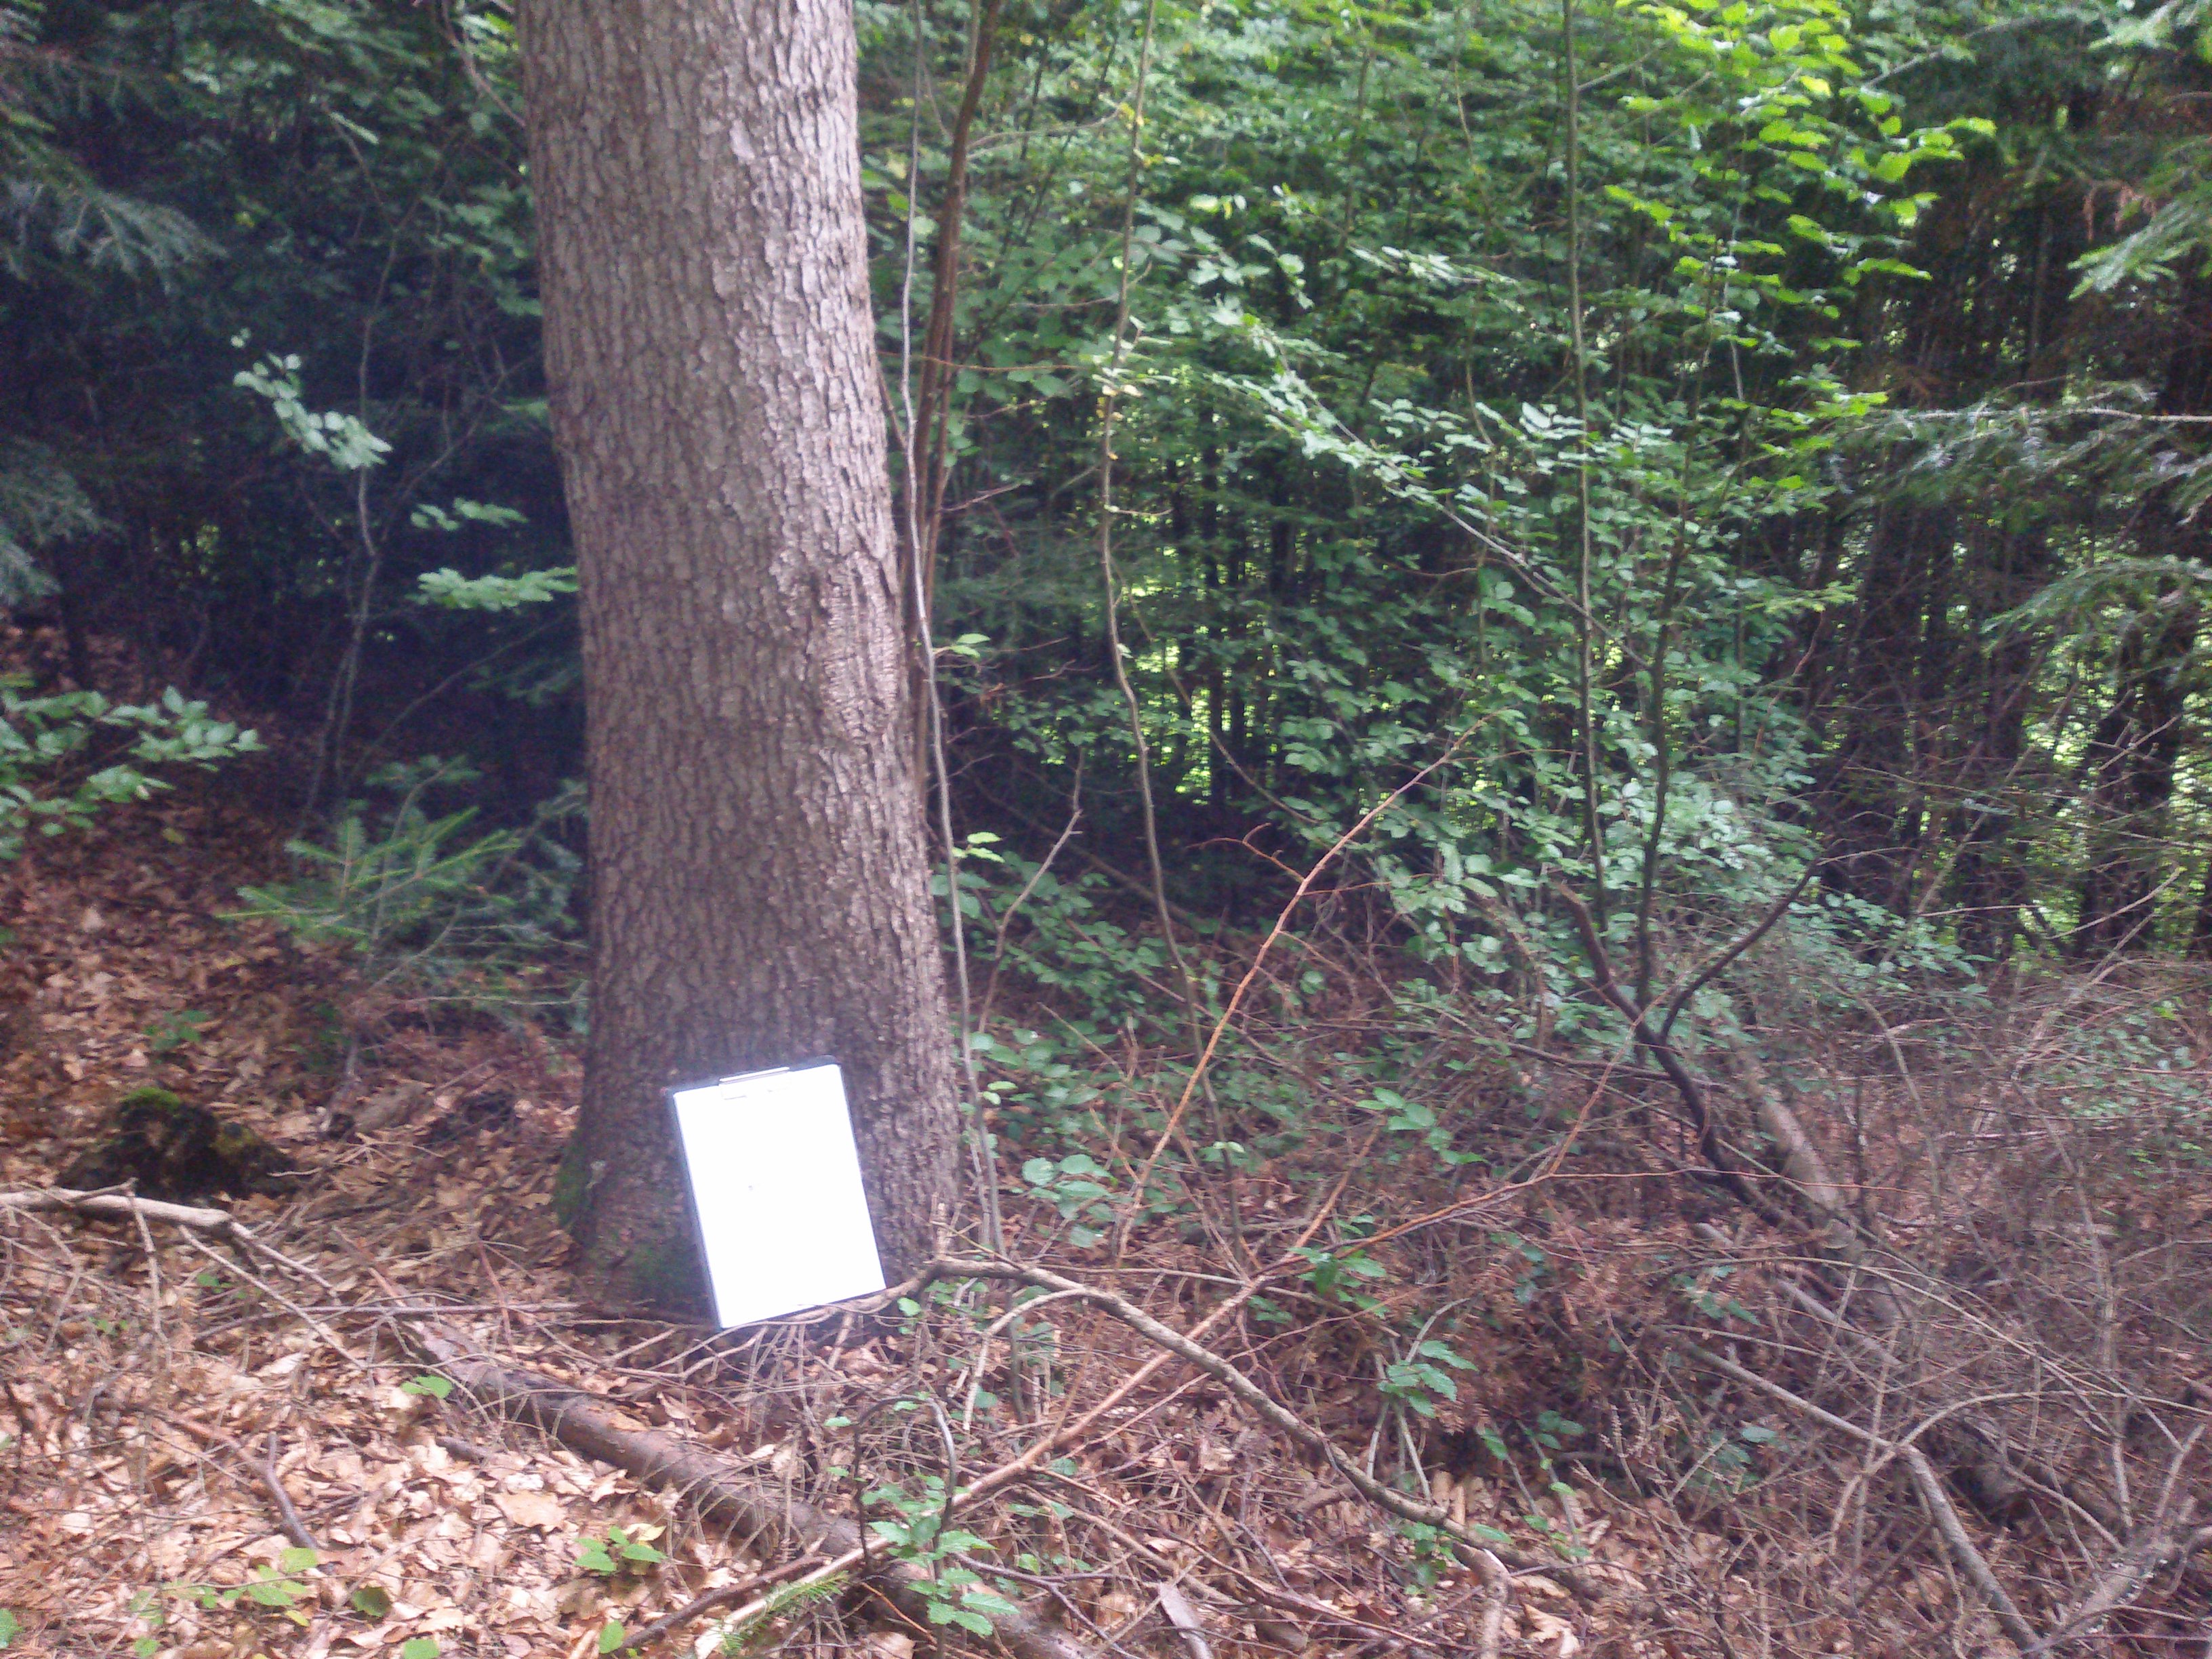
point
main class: Woodland
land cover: Other mixed woodland
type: hemiboreal forest and nemoral coniferous forest and mixed broadleaved-coniferous forest
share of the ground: > 75 %
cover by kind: broadleaved forest trees 50 %, coniferous forest trees 30 %, unconsolidated bare surface 10 %, shrubs 5 %, herbaceous plants 5 %
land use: Forestry
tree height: > 5 m
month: July
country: PL
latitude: 49.7381
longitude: 22.2576
